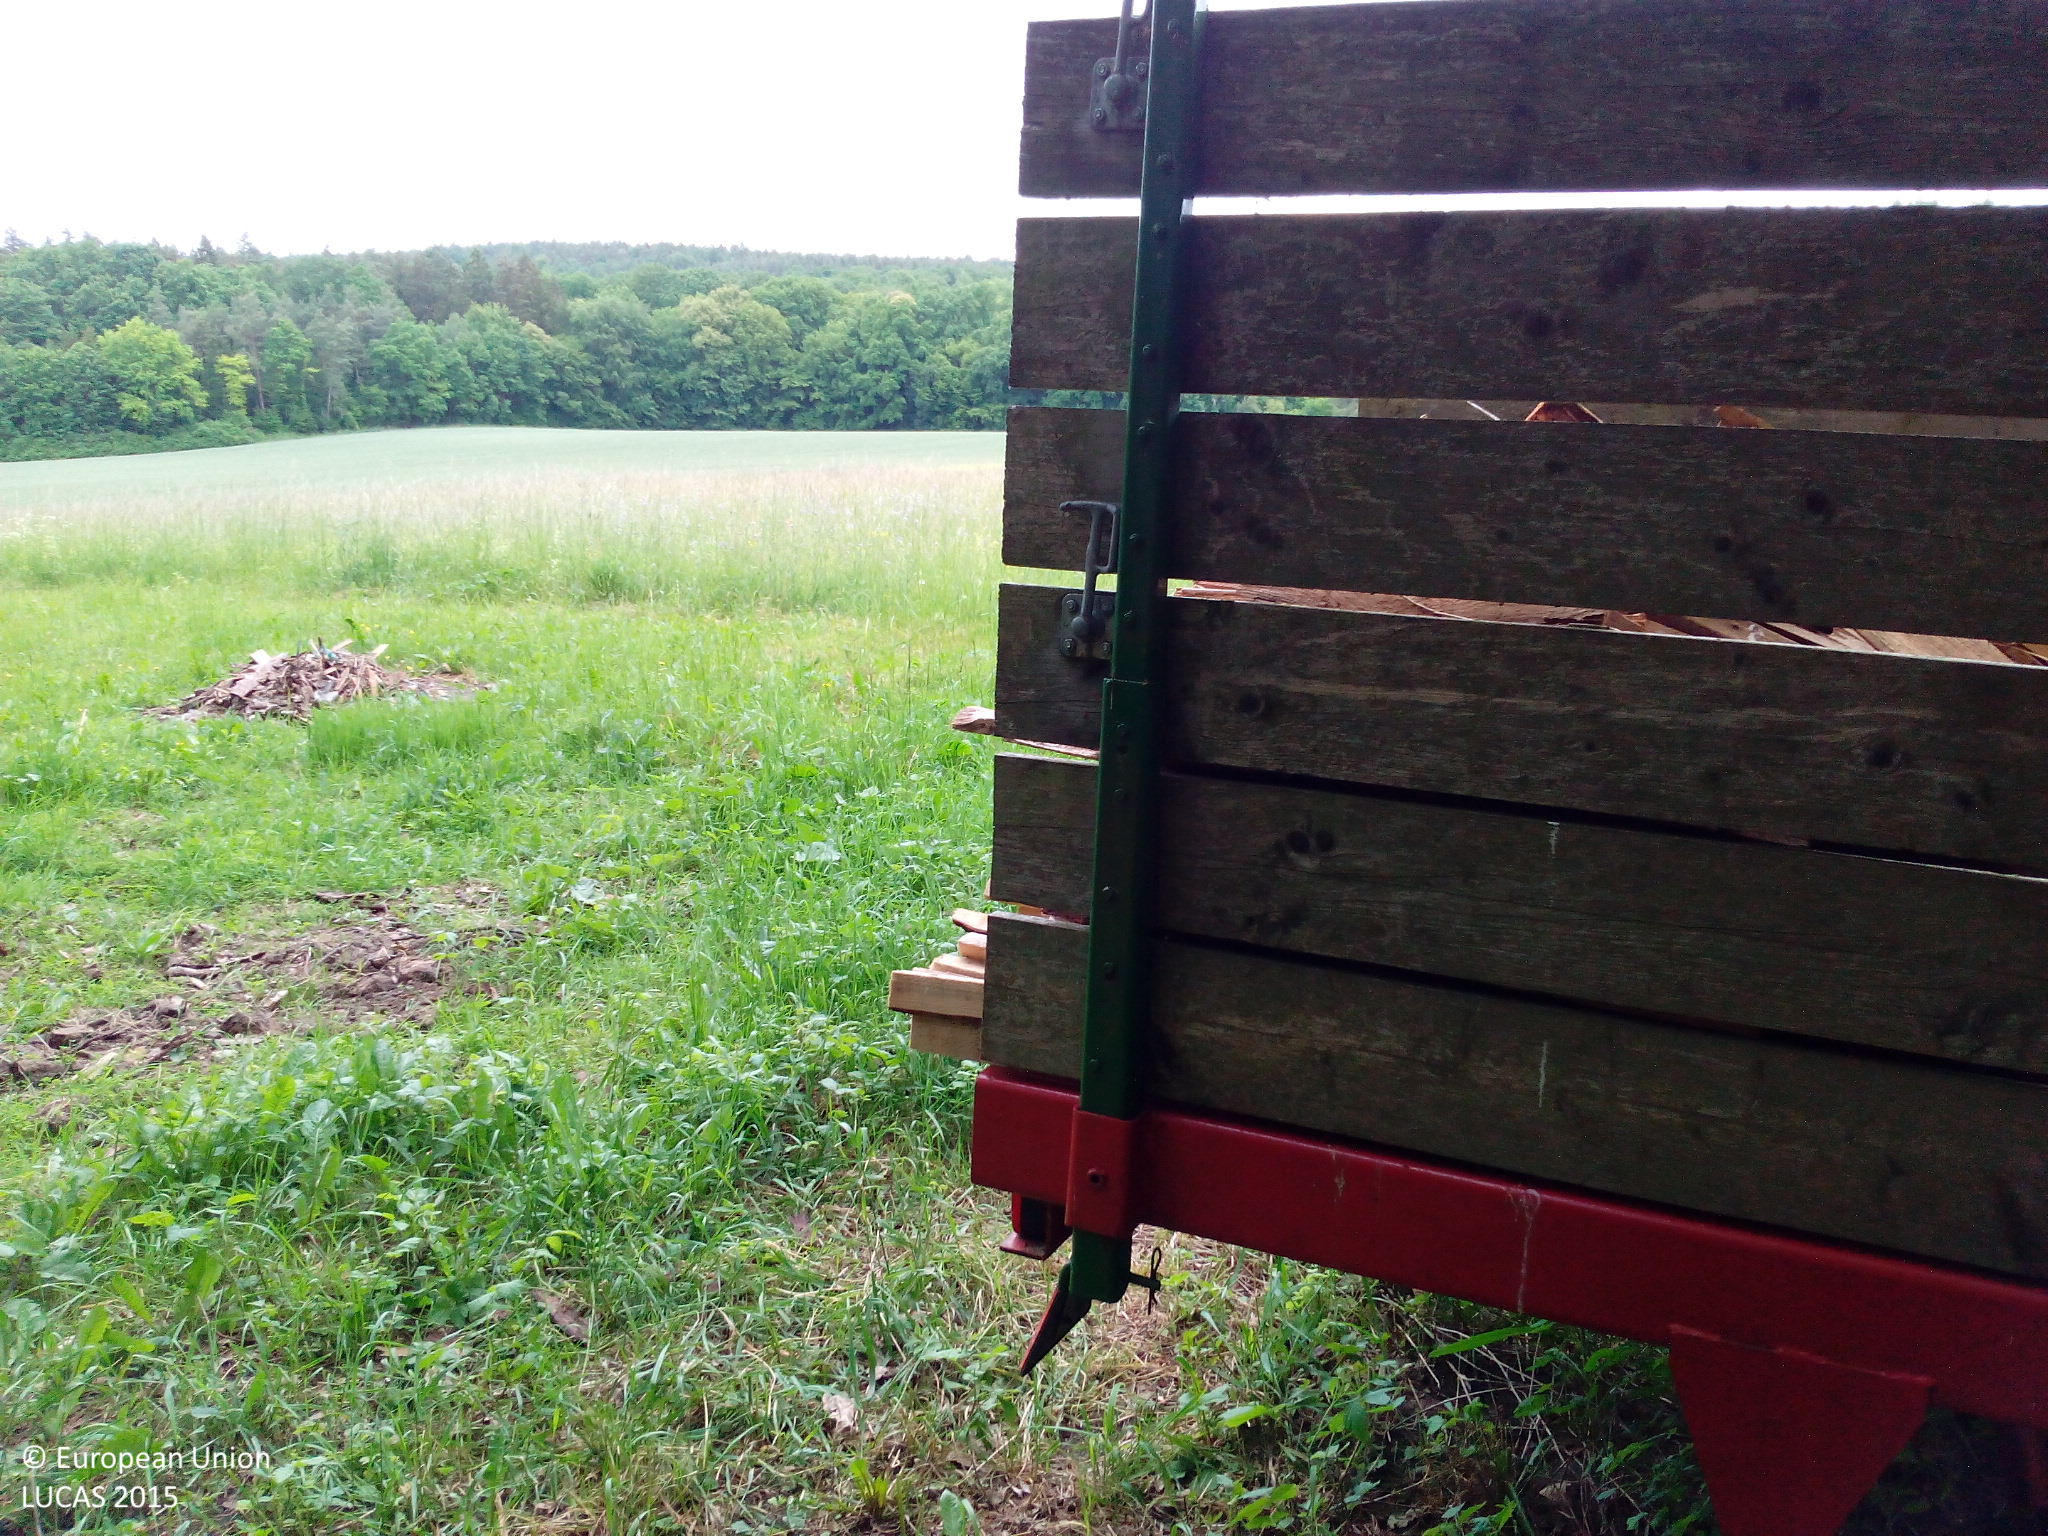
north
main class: Grassland
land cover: Grassland without tree/shrub cover
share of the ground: > 75 %
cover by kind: herbaceous plants 100 %
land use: Agriculture (excluding fallow land and kitchen gardens)
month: June
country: DE
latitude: 50.0367
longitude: 10.9072
